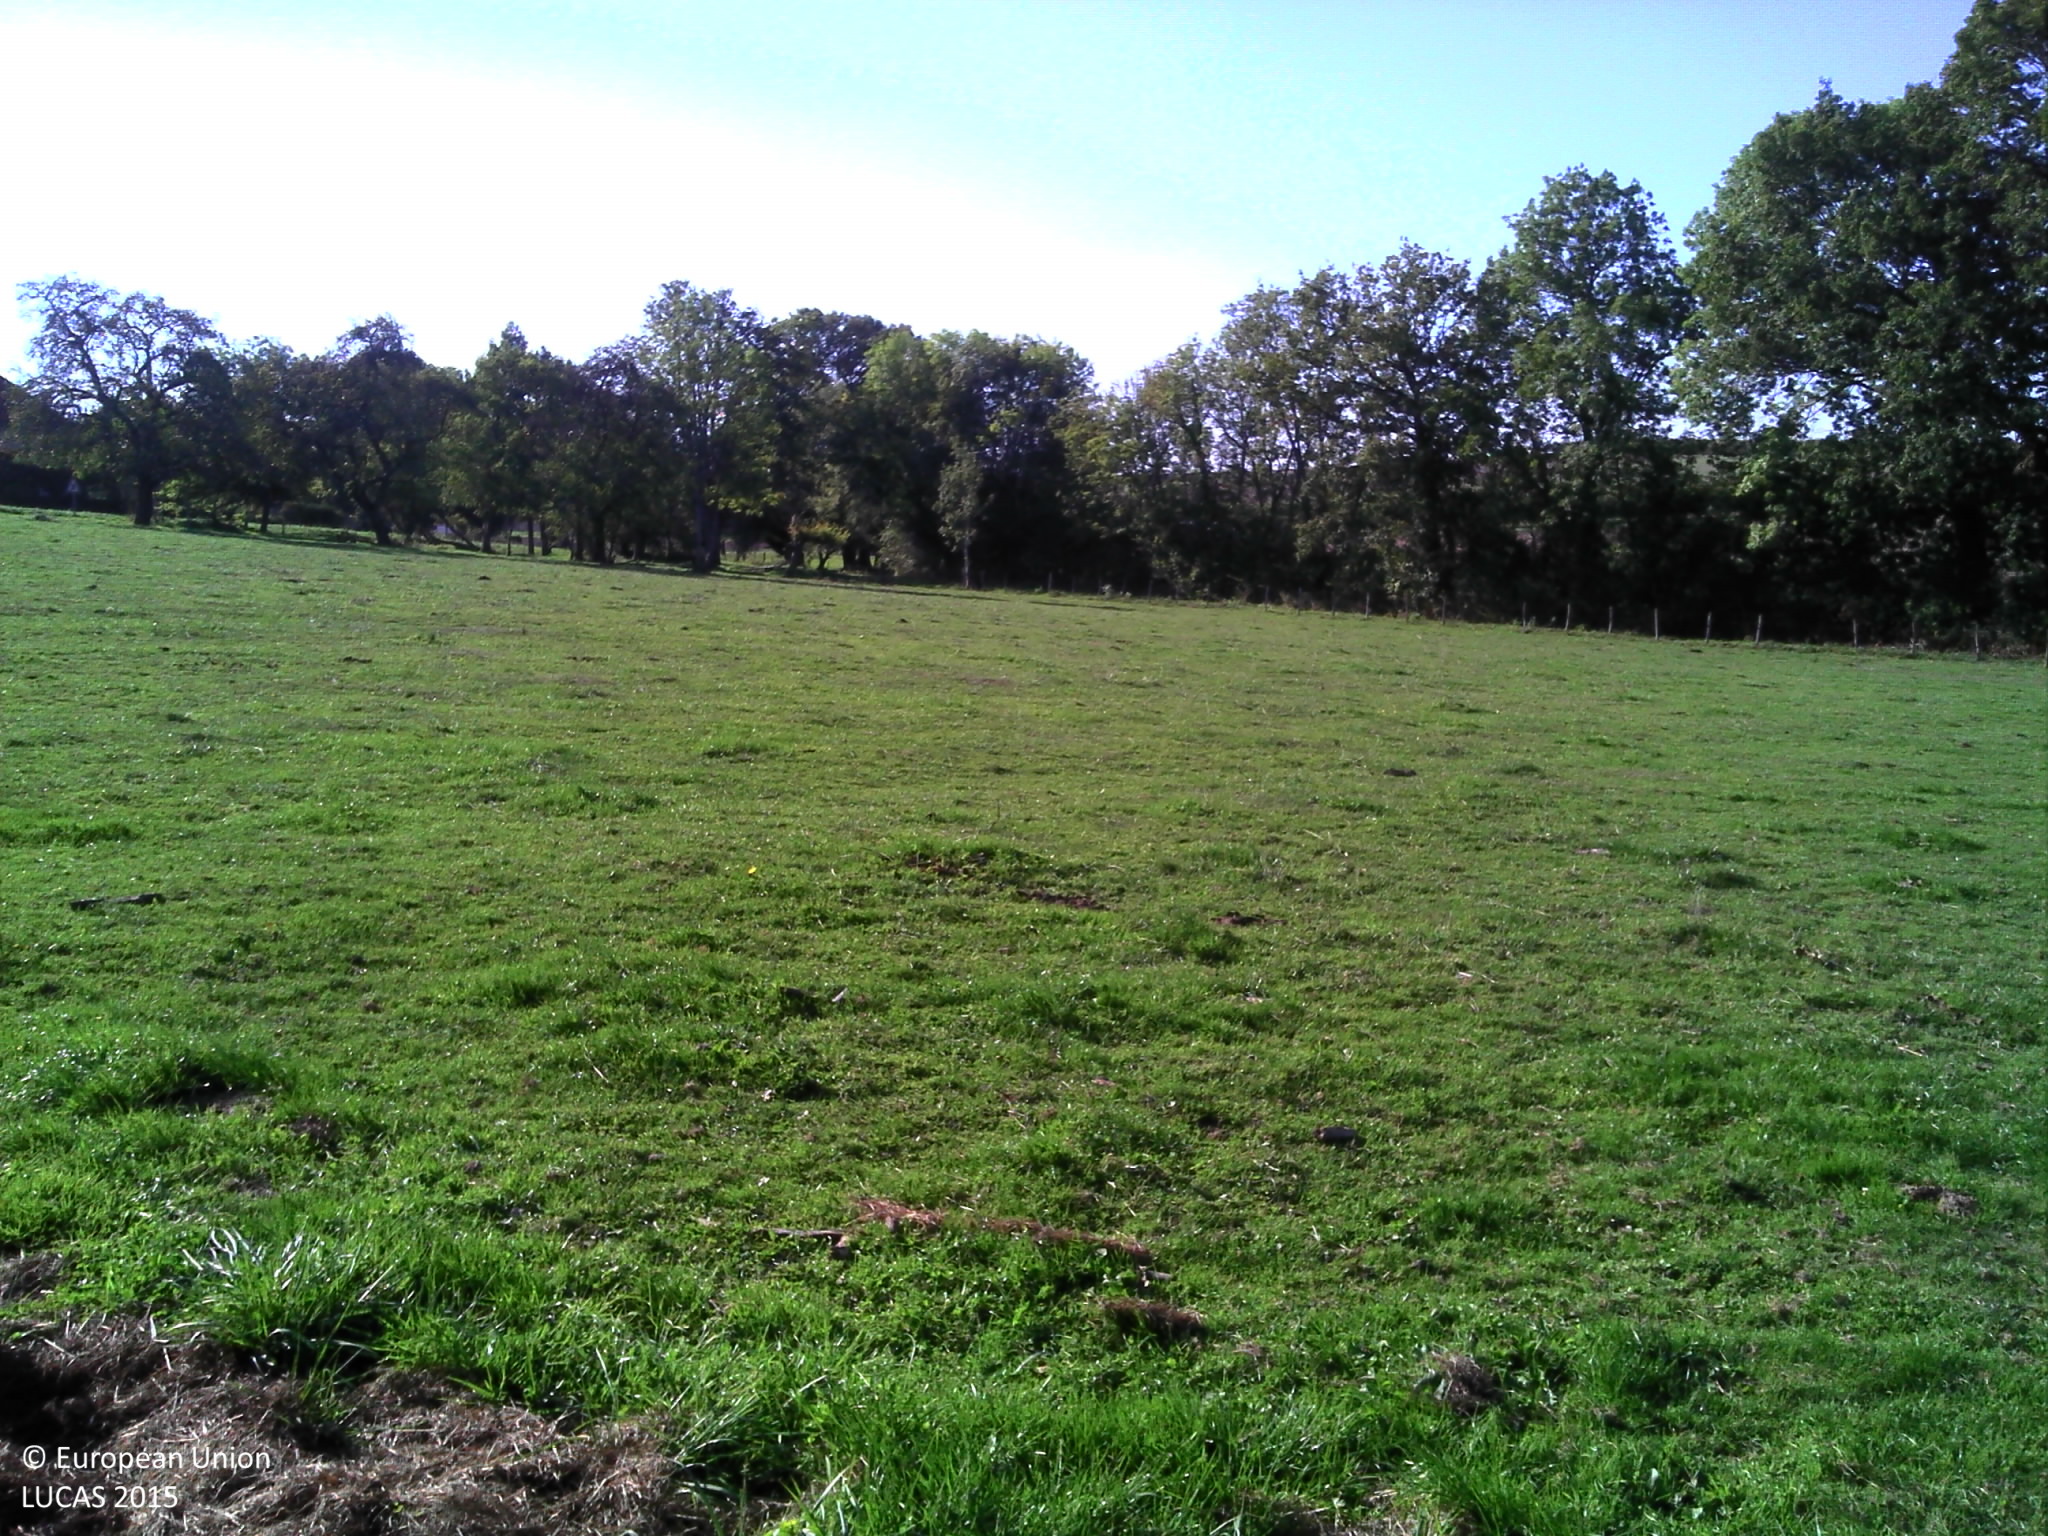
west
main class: Grassland
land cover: Grassland with sparse tree/shrub cover
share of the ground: > 75 %
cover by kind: herbaceous plants 95 %, broadleaved forest trees 5 %
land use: Agriculture (excluding fallow land and kitchen gardens)
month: September
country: FR
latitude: 48.0721
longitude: 3.8895
